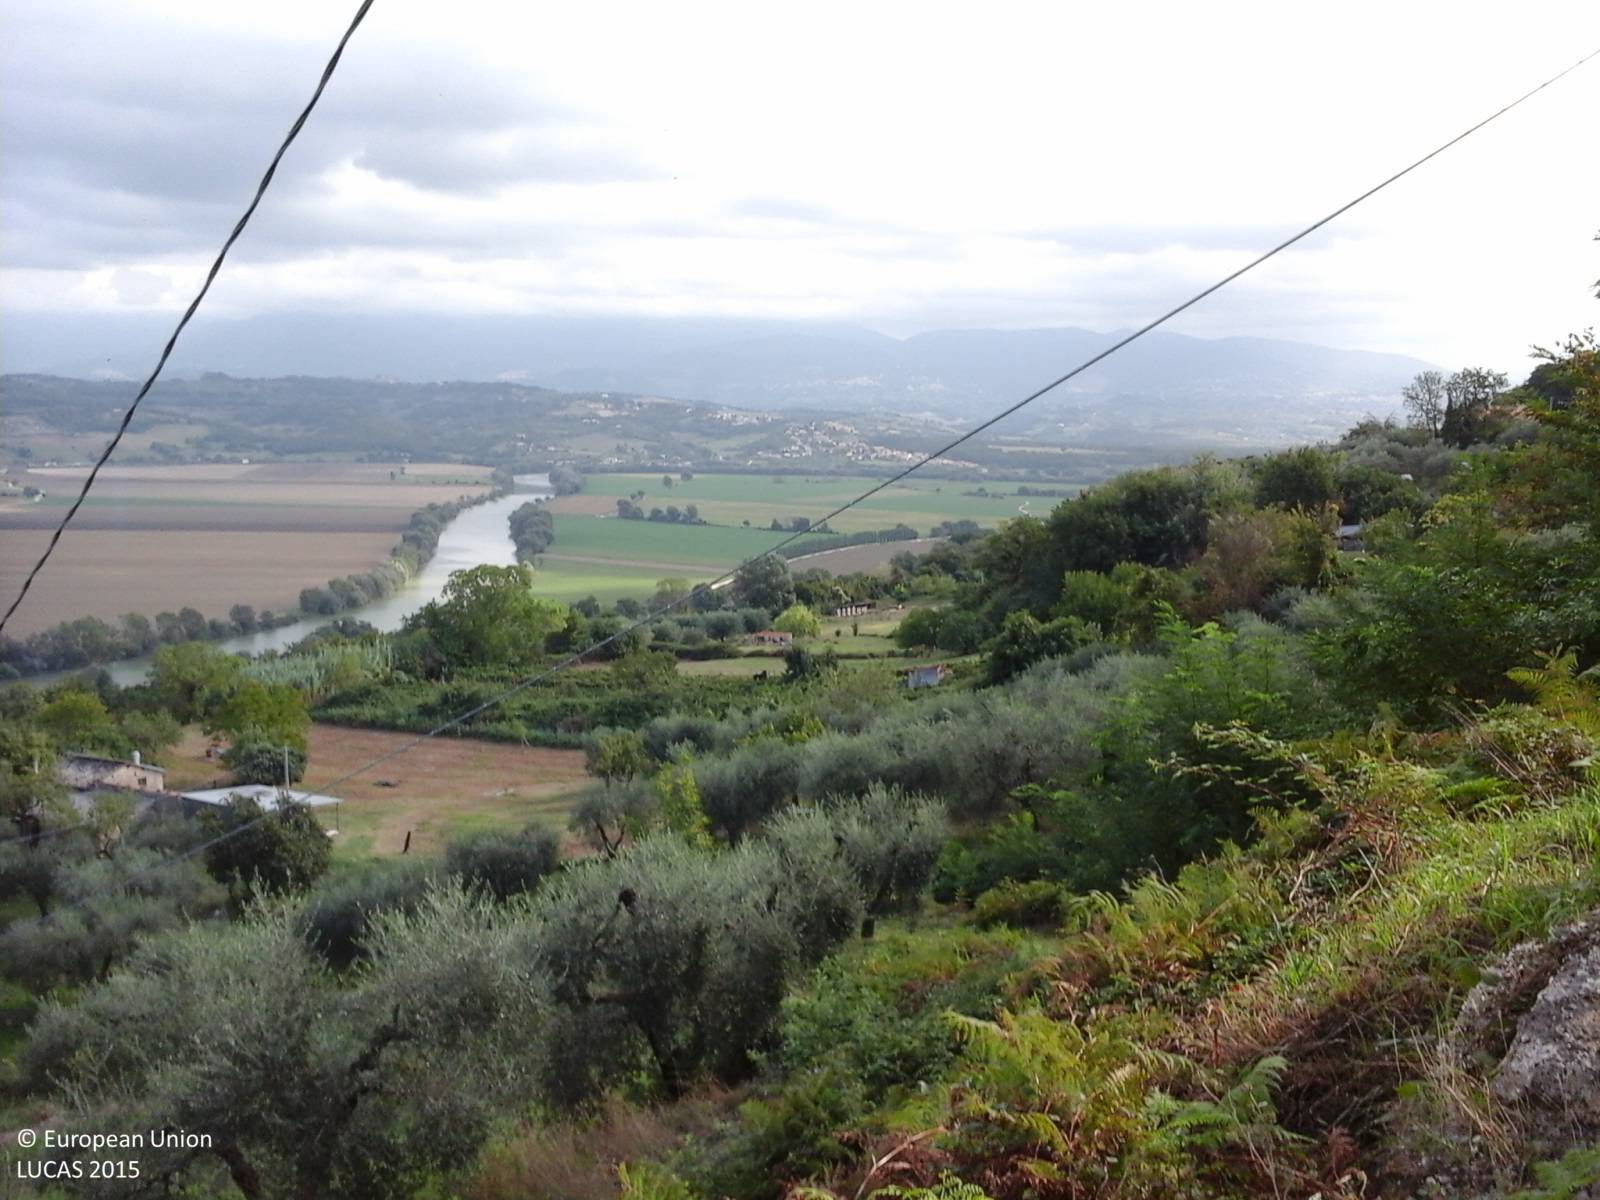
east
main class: Cropland
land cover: Olive groves
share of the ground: 50 - 75 %
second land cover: Spontaneously vegetated surfaces
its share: > 75 %
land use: Kitchen garden
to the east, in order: Olive groves; Spontaneously vegetated surfaces; Artificial constructions in urban areas; Ditches and canals; Fences; Olive groves; Electric lines; Olive groves; Nuts trees; Artificial constructions in urban areas; Grassland without tree/shrub cover; Vineyards; Nuts trees; Grassland without tree/shrub cover; Abandoned hedges; Tracks; Grassland without tree/shrub cover
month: September
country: IT
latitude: 42.2599
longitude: 12.5732
